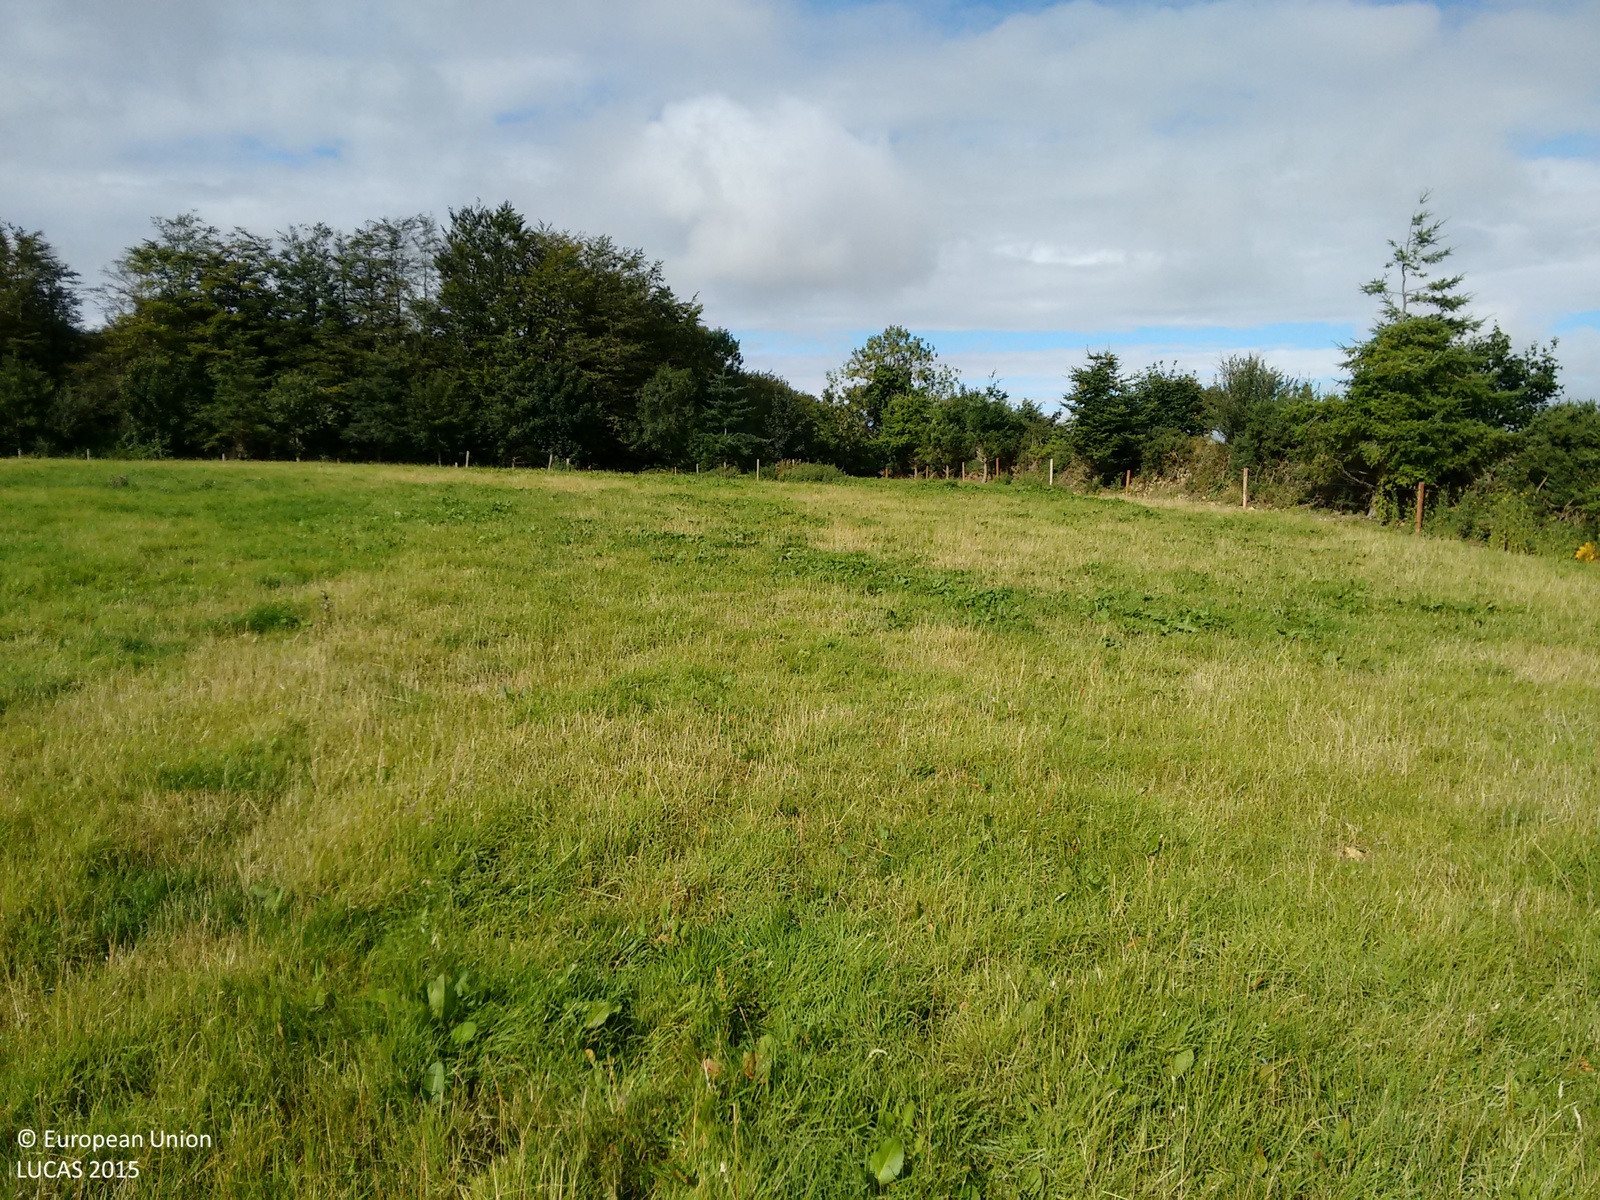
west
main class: Grassland
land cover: Grassland without tree/shrub cover
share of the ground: > 75 %
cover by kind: herbaceous plants 100 %
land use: Agriculture (excluding fallow land and kitchen gardens)
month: August
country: IE
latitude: 52.4216
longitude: -6.6454
